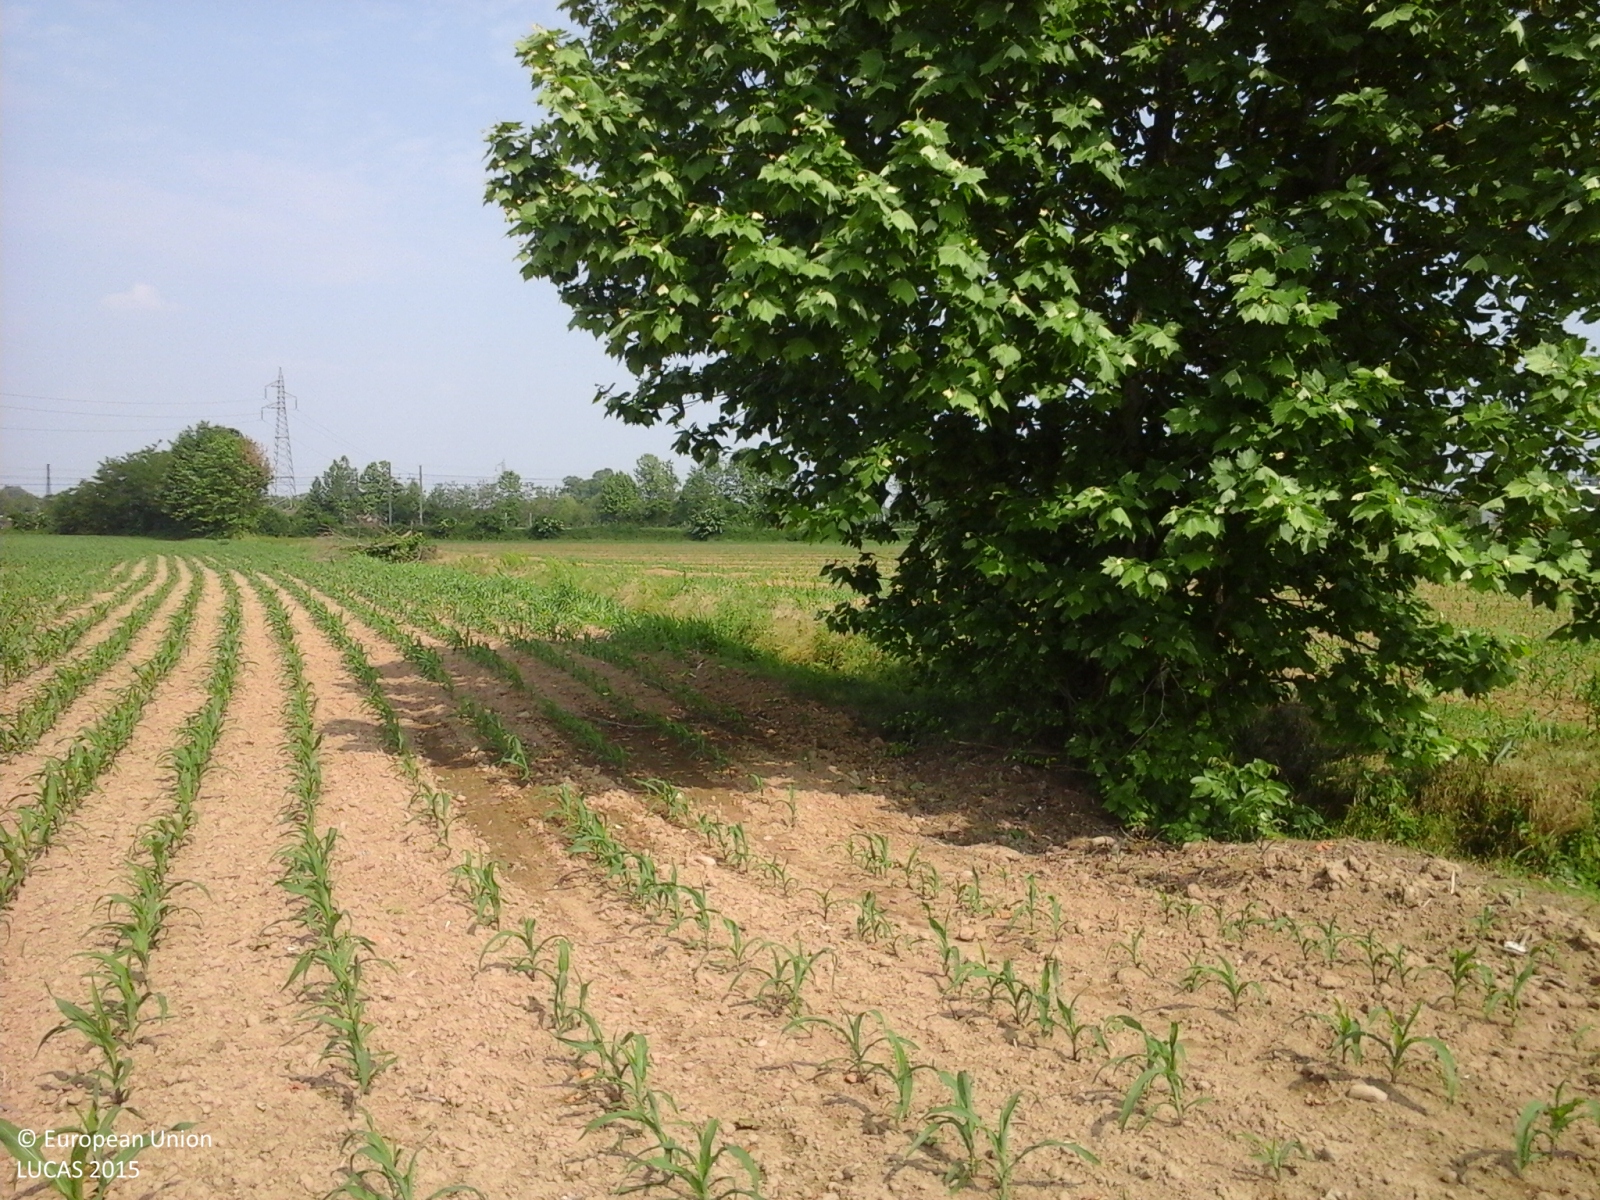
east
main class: Cropland
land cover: Maize
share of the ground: 10 - 25 %
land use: Agriculture (excluding fallow land and kitchen gardens)
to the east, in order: Maize; Grass margins; Ditches and canals; Grass margins; Maize; Grass margins; Ditches and canals; Abandoned hedges; Railways; Abandoned hedges; Ditches and canals; Grass margins; Maize
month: May
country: IT
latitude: 45.6299
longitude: 9.6286
